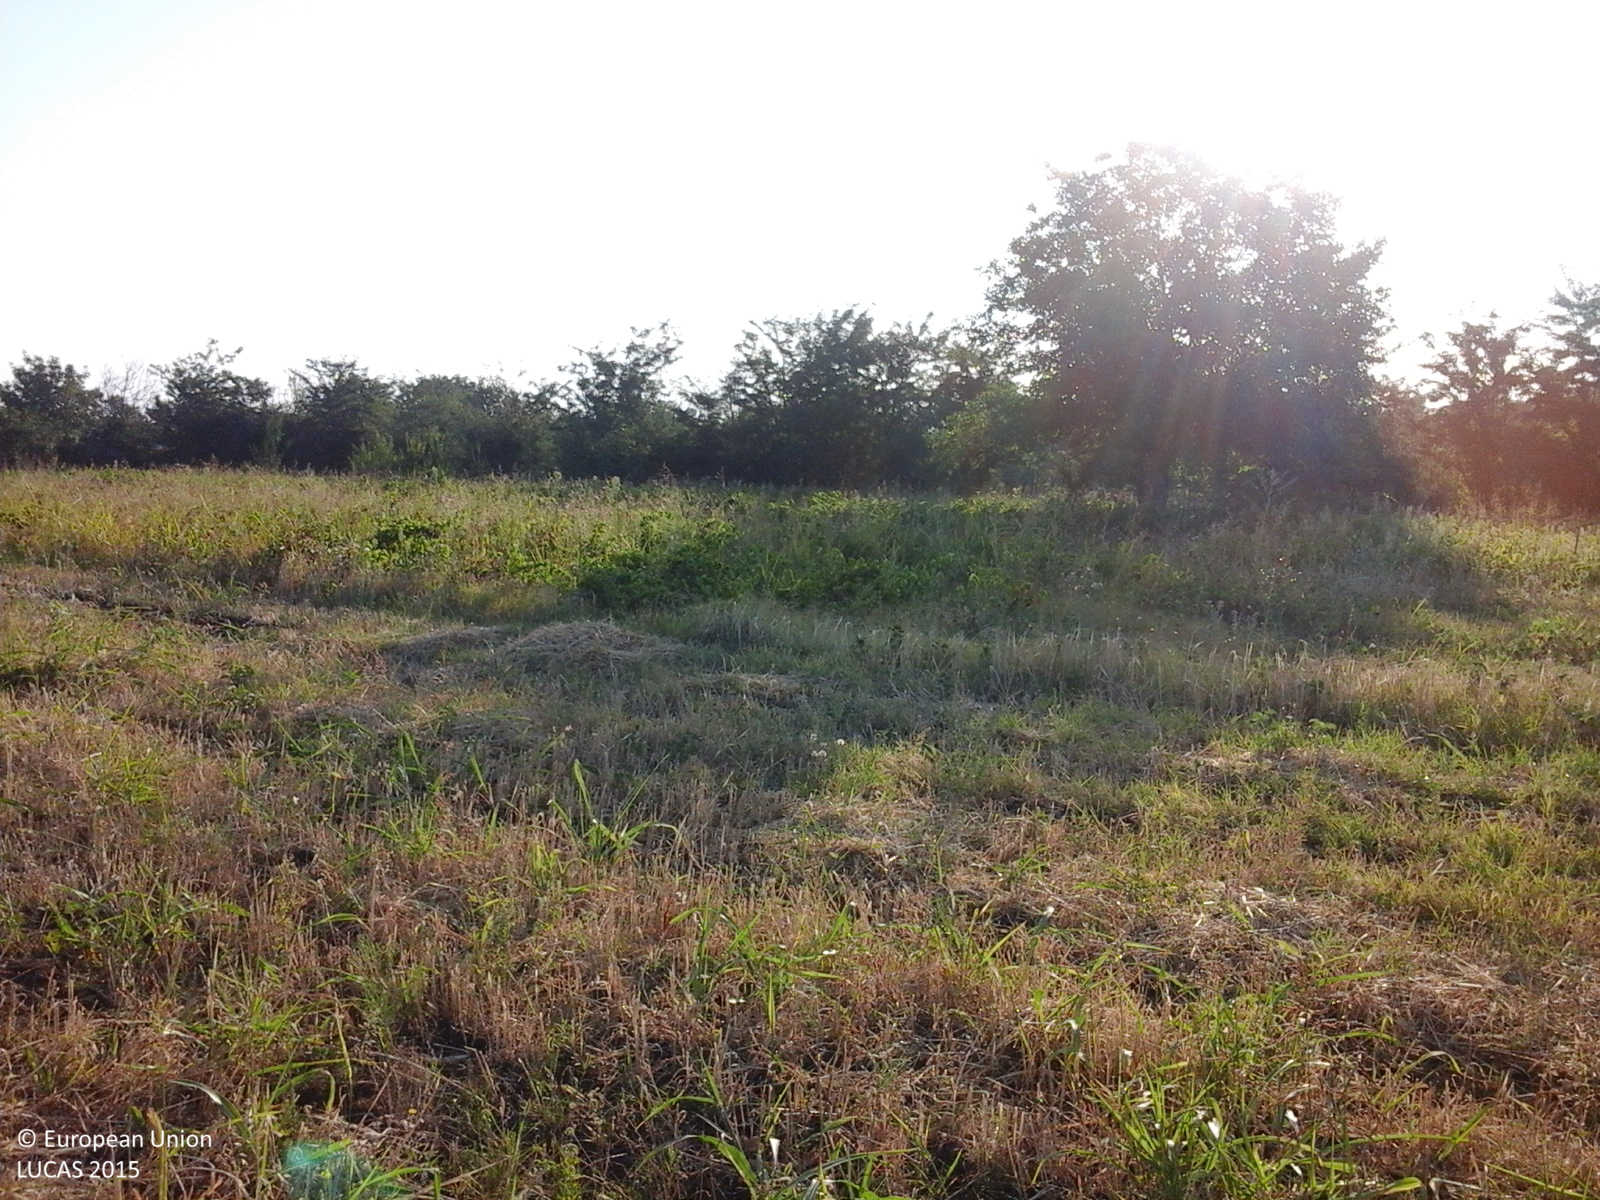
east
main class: Cropland
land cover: Other fresh vegetables
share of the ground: > 75 %
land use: Agriculture (excluding fallow land and kitchen gardens)
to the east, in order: Other fresh vegetables; Triticale; Vineyards; Lucerne; Vineyards; Abandoned hedges; Grass margins; Tracks; Grass margins; Abandoned hedges; Lucerne; Abandoned hedges; Tracks; Abandoned hedges; Lucerne; Artificial constructions in urban areas; Lucerne; Fences; Vineyards; Lucerne; Artificial constructions in urban areas; Other fresh vegetables; Lucerne
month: August
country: RO
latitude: 44.1009
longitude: 23.3771
